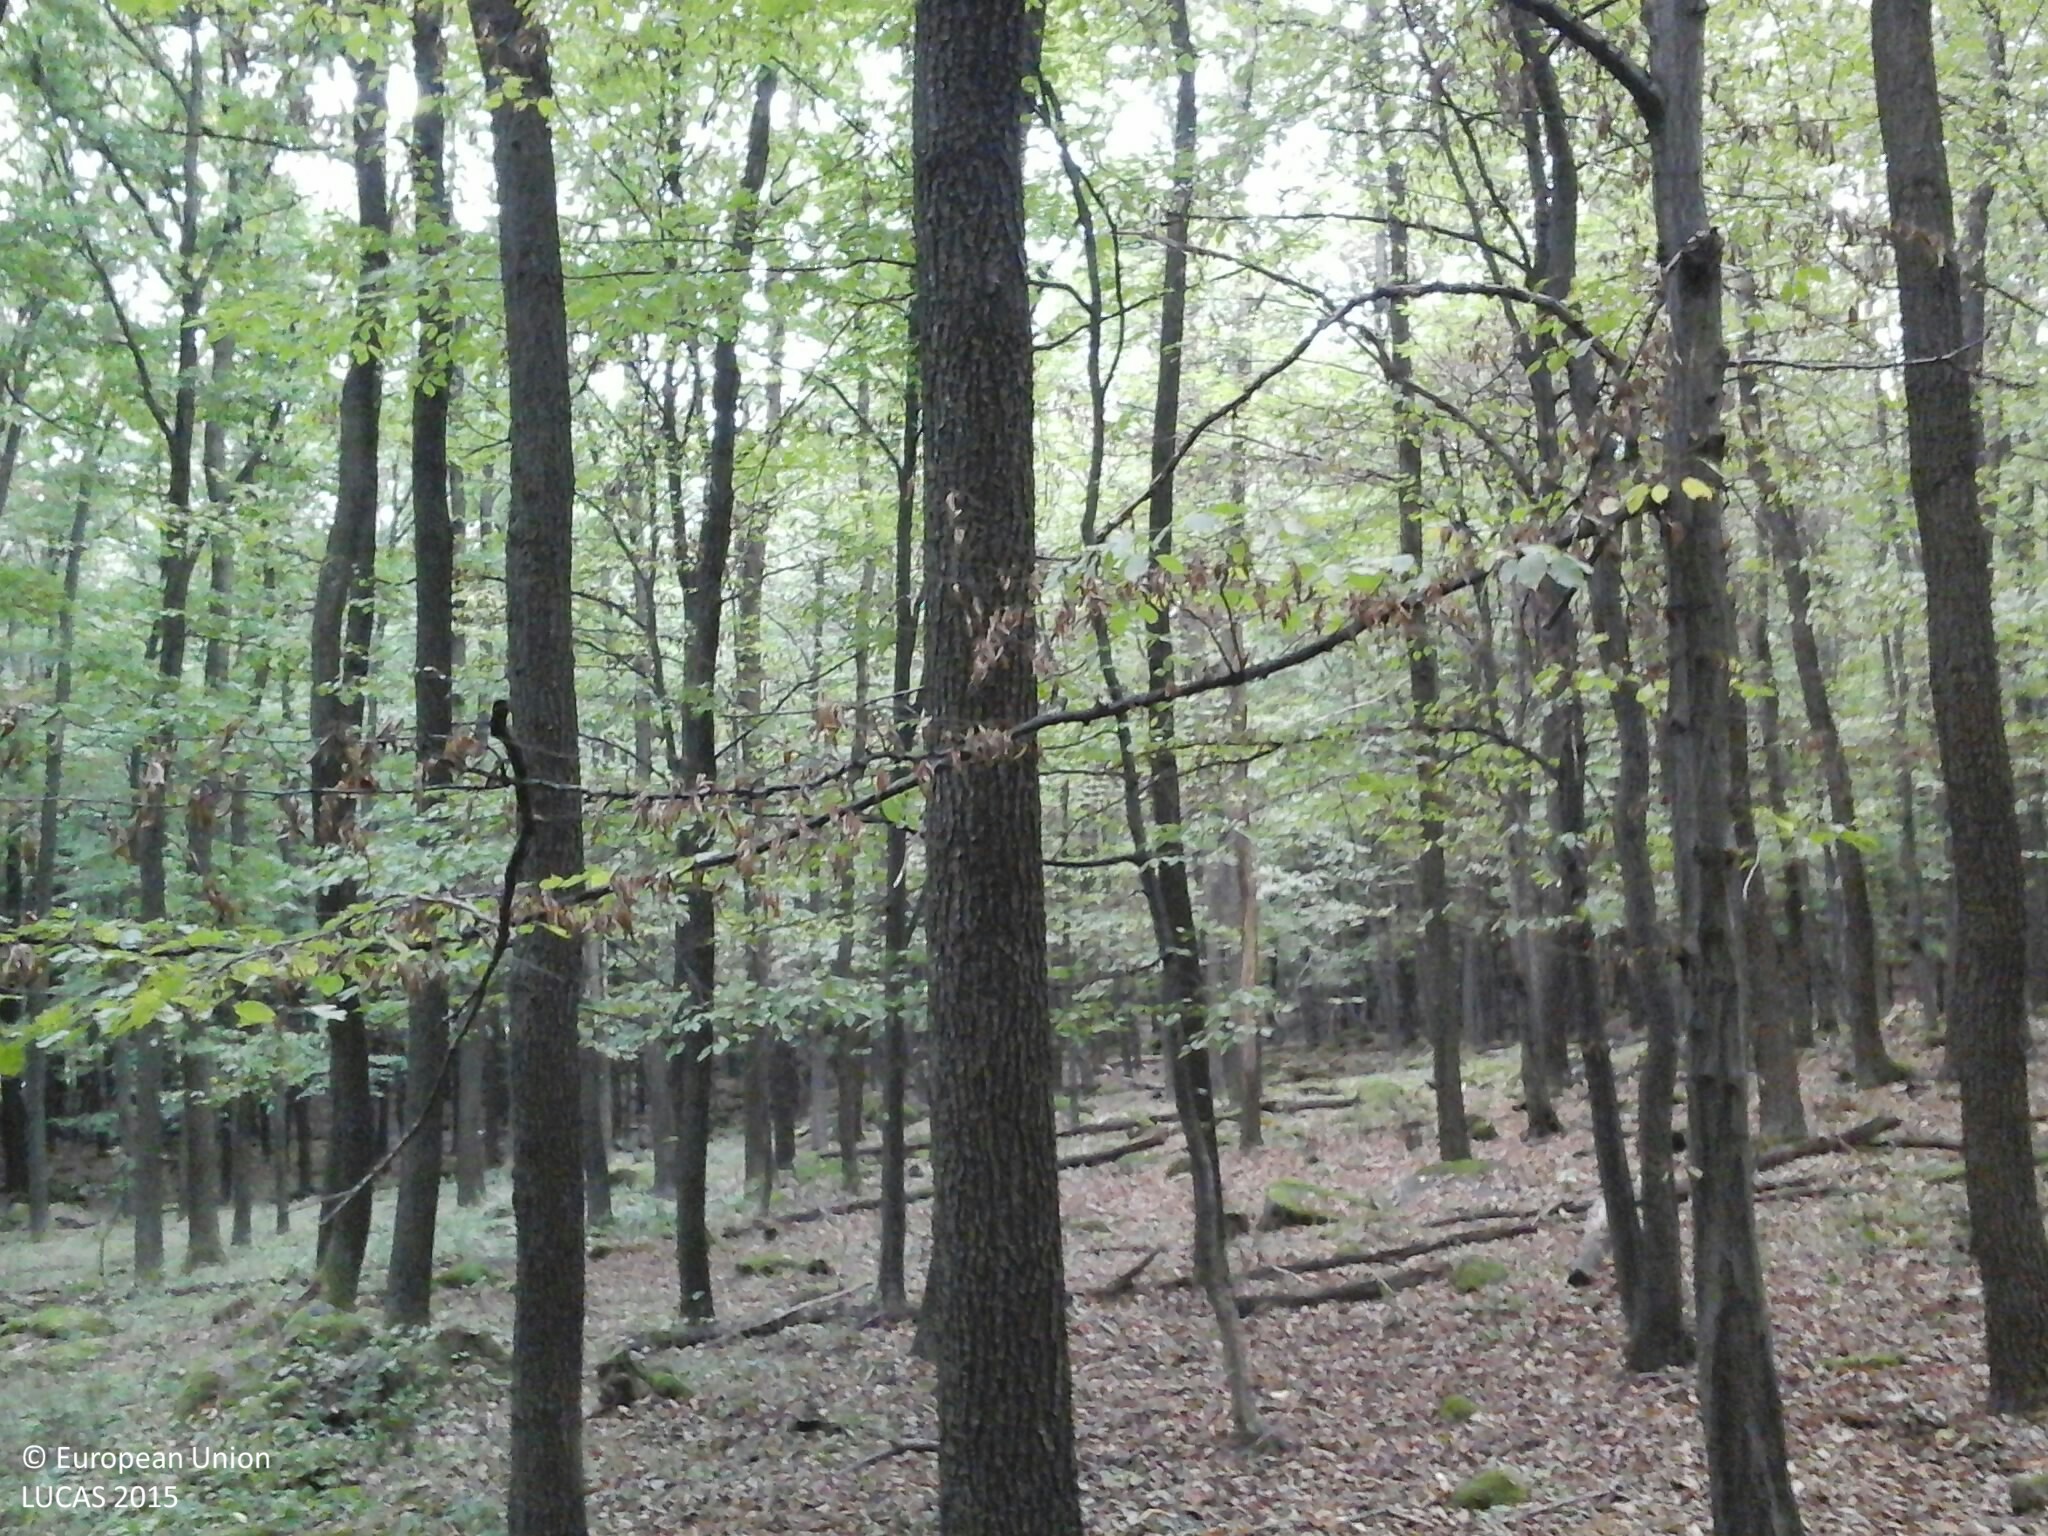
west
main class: Woodland
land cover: Broadleaved woodland
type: mesophytic deciduous forest
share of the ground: > 75 %
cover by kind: broadleaved forest trees 95 %, herbaceous plants 5 %
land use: Forestry
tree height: > 5 m
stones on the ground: 10 - 25 %
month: September
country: HU
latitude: 47.8597
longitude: 19.9853
